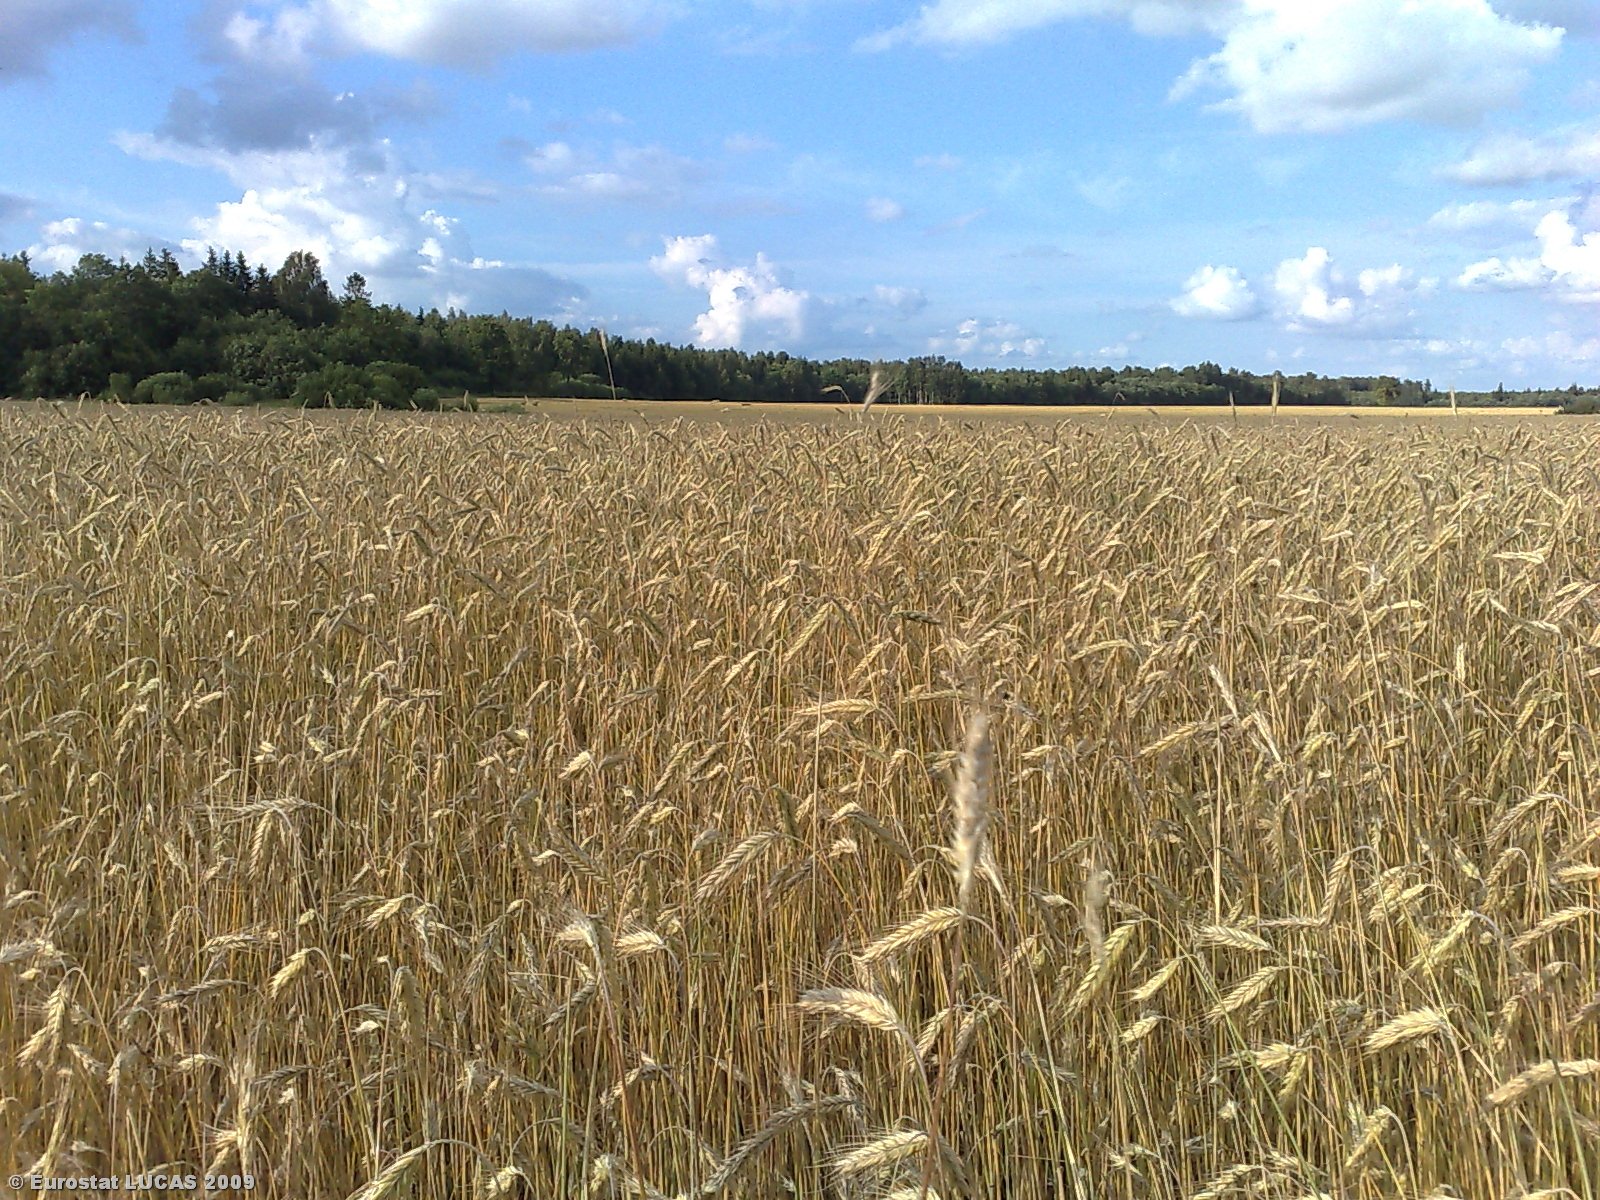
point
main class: Cropland
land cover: Rye
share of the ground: > 75 %
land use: Agriculture (excluding fallow land and kitchen gardens)
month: July
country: LT
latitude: 56.1471
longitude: 22.9594
